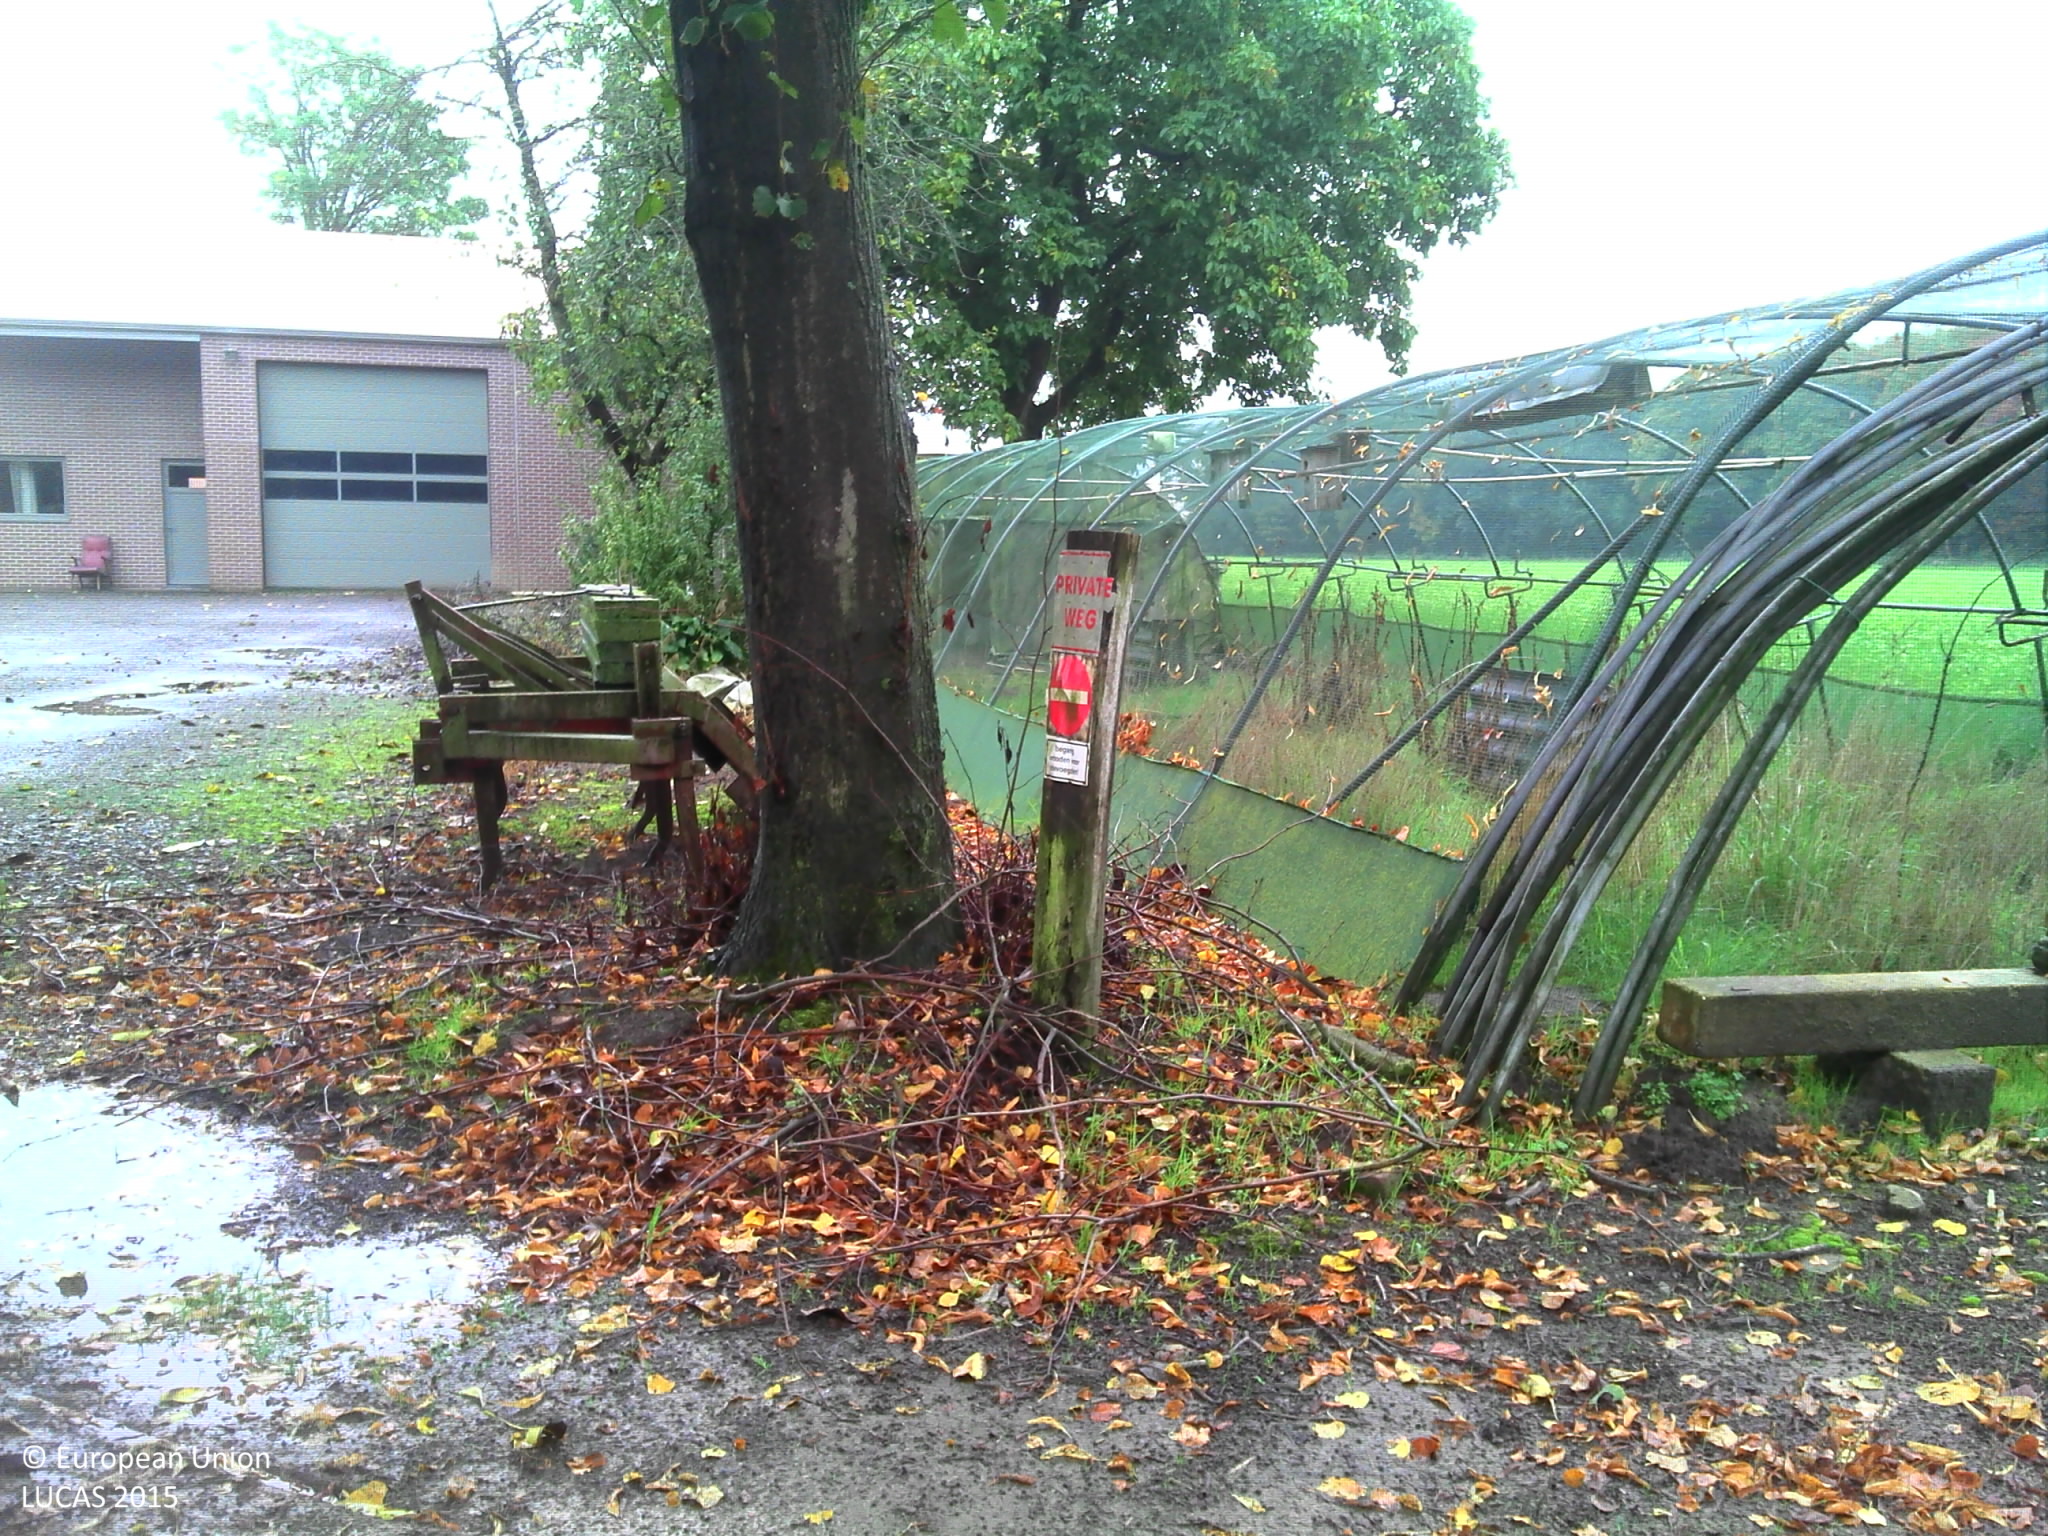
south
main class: Cropland
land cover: Other fibre and oleaginous crops
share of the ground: 50 - 75 %
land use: Agriculture (excluding fallow land and kitchen gardens)
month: October
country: BE
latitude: 50.9599
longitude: 2.9707
